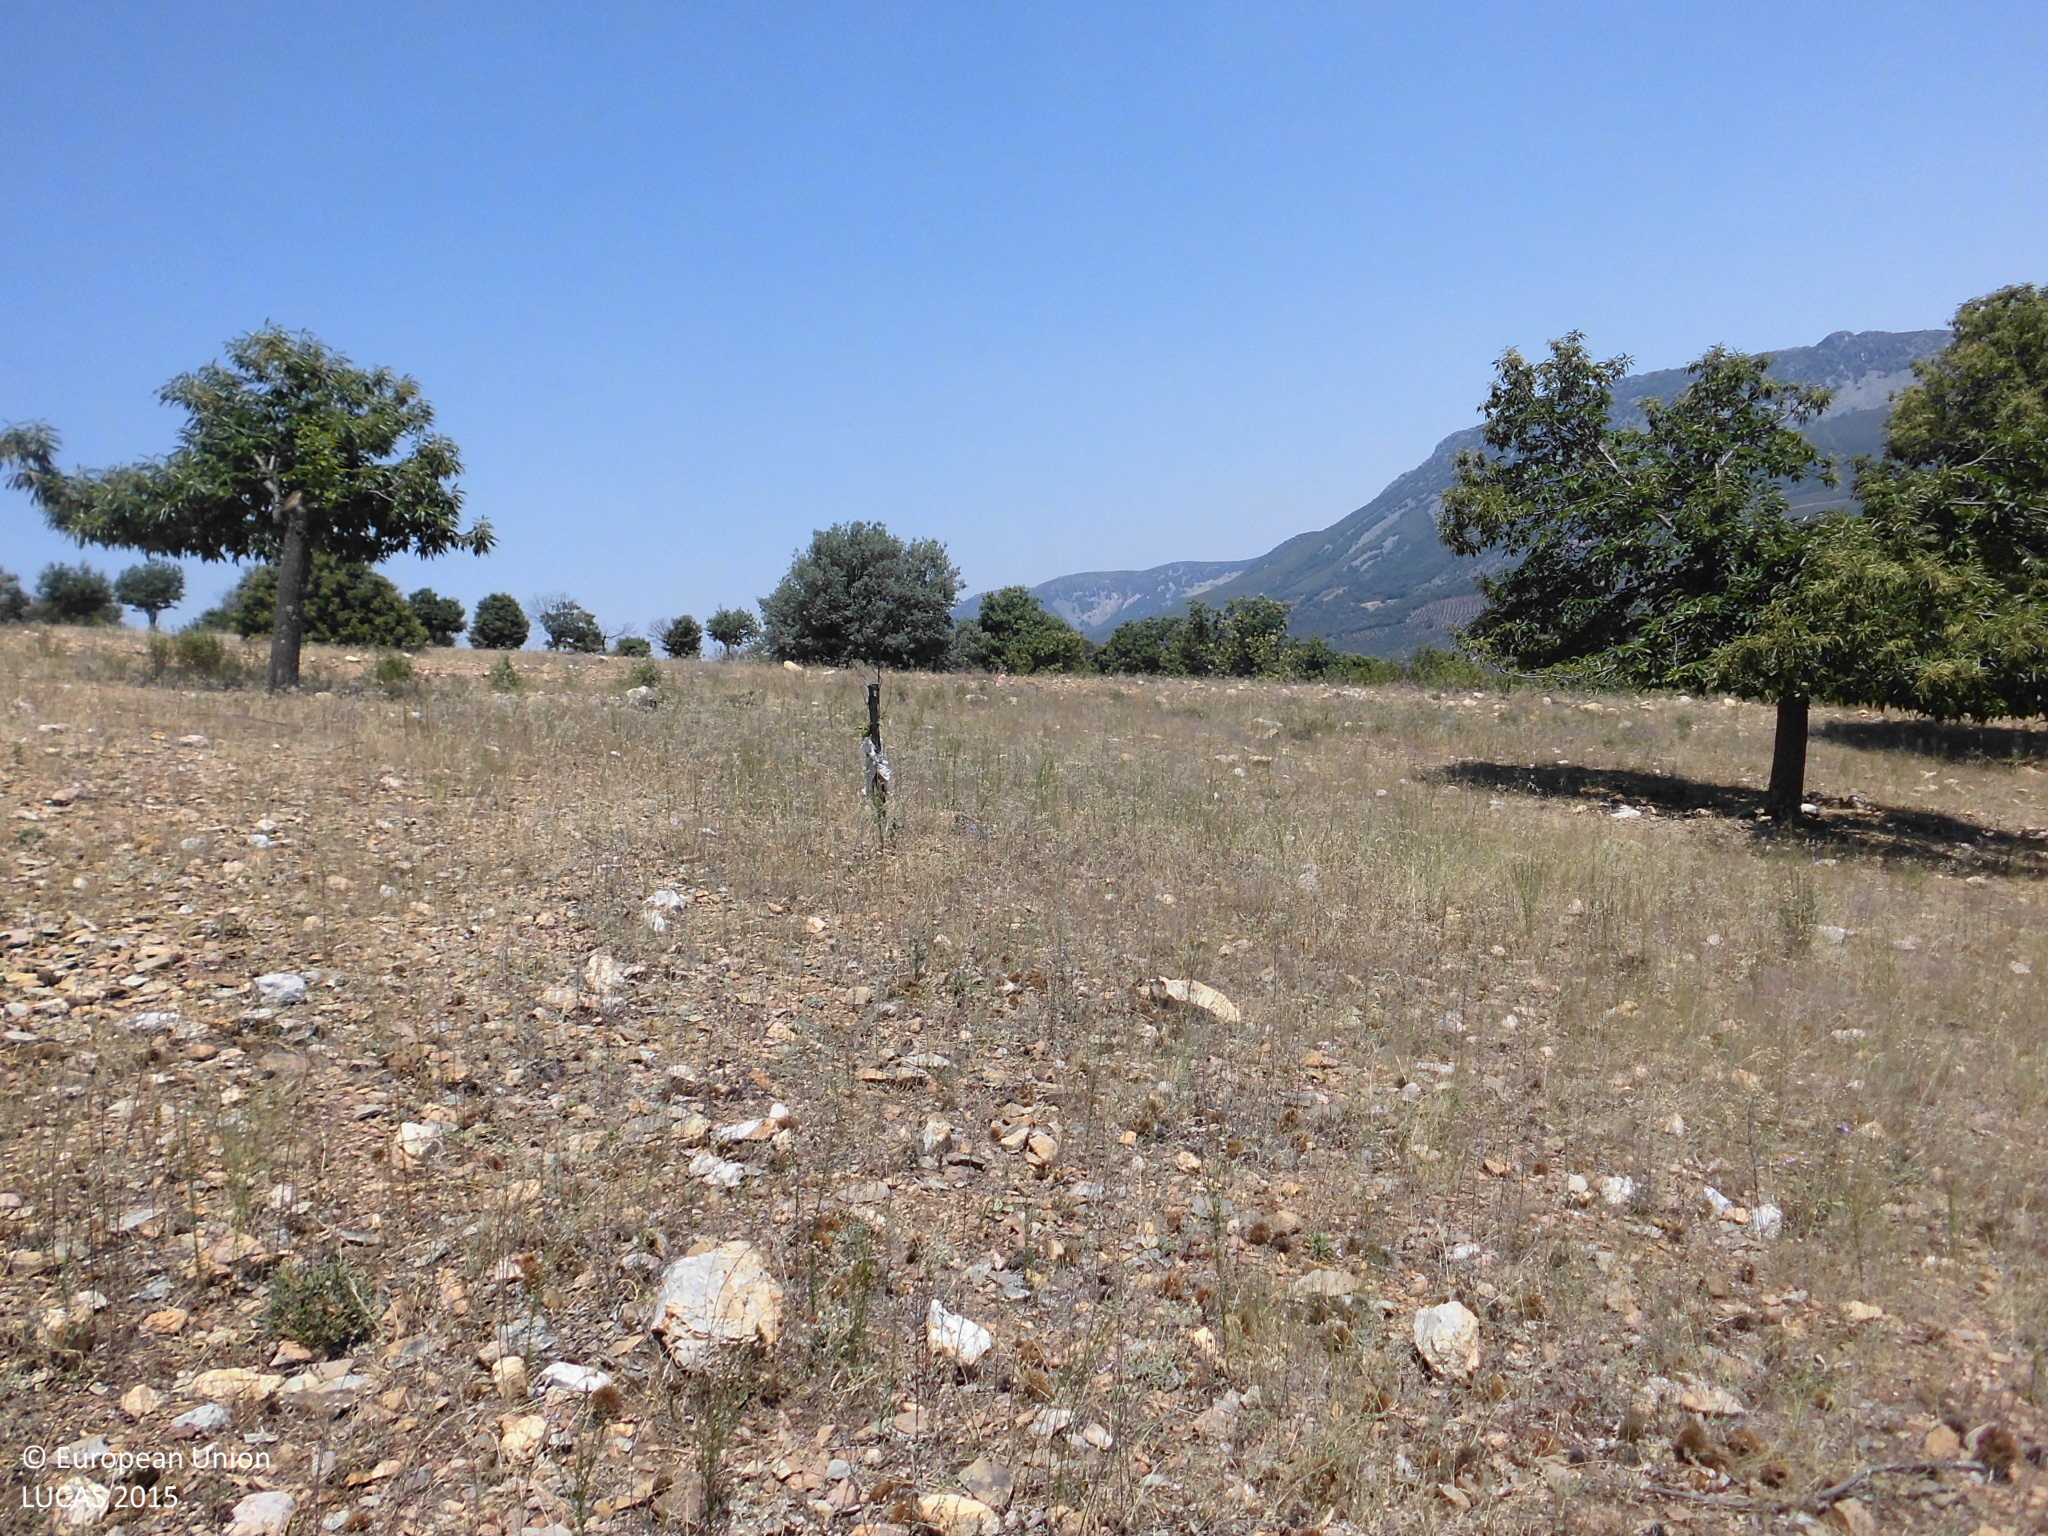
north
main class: Cropland
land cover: Nuts trees
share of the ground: 10 - 25 %
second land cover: Grassland without tree/shrub cover
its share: 50 - 75 %
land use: Agriculture (excluding fallow land and kitchen gardens)
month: June
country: ES
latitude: 39.5399
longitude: -5.3981
